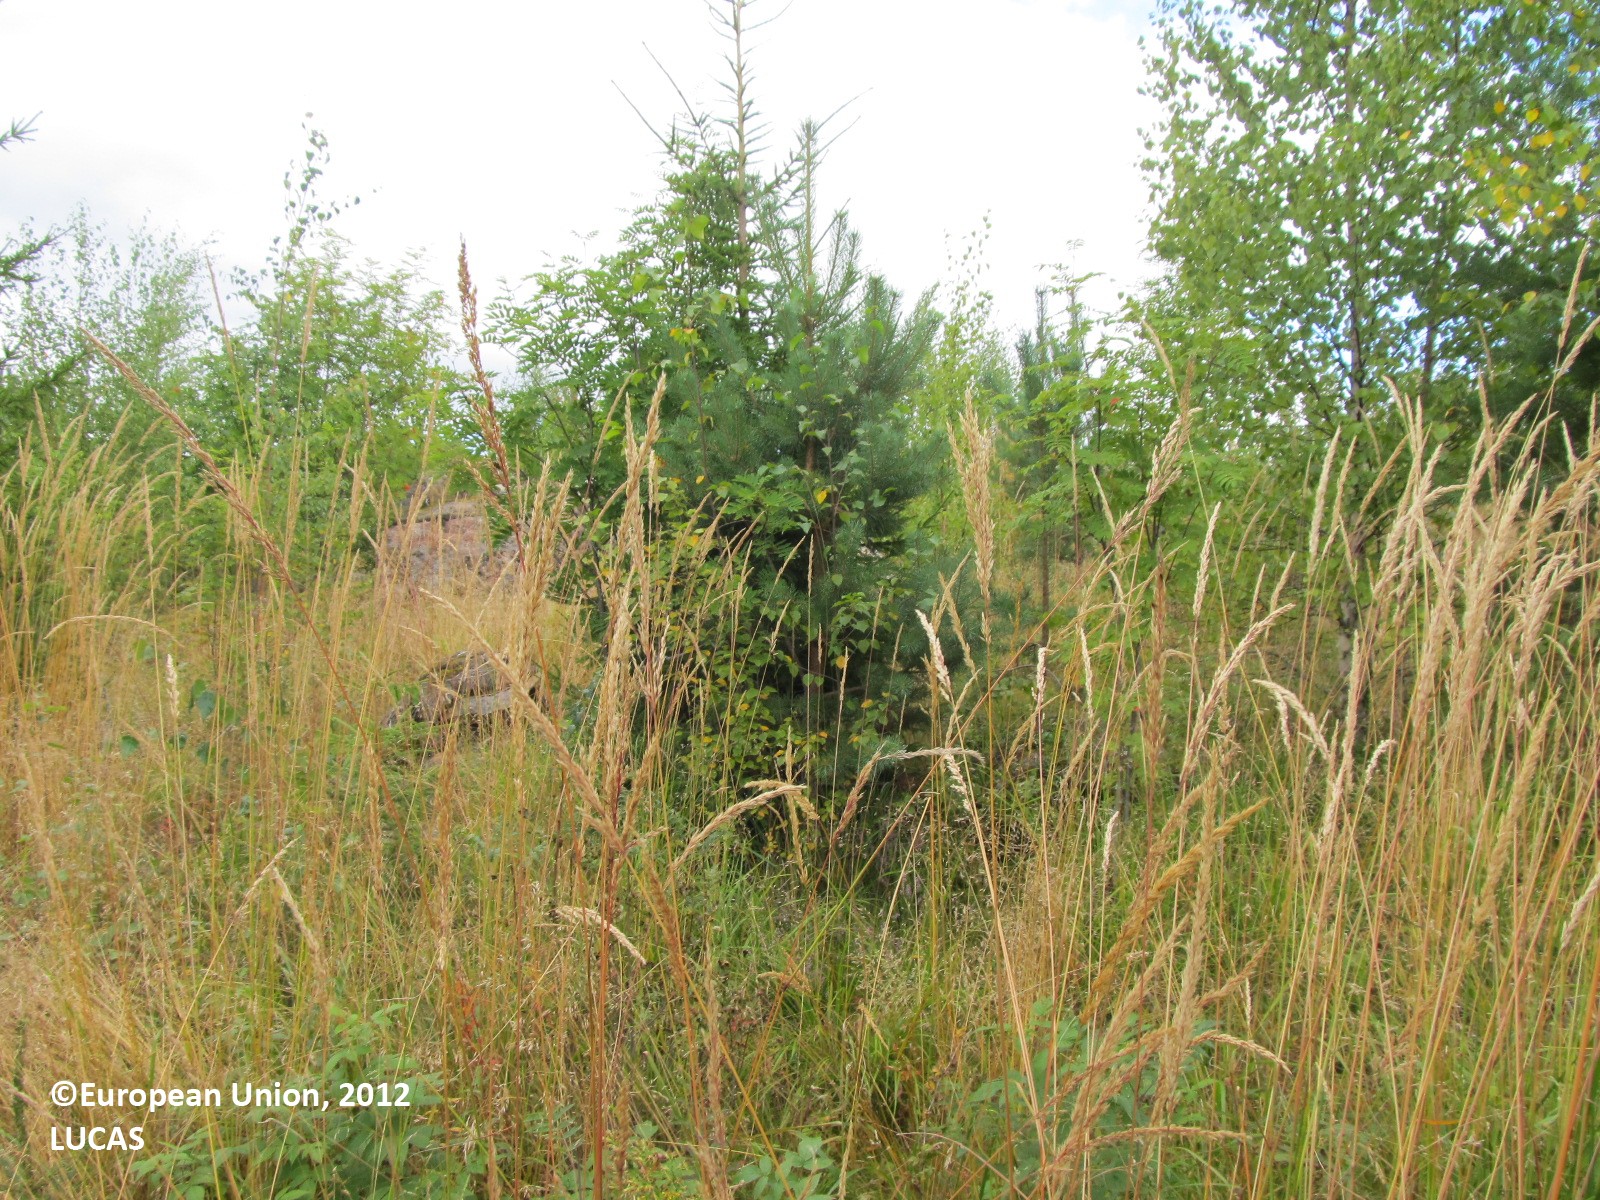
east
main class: Woodland
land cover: Spruce dominated mixed woodland
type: boreal forest
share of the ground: 25 - 50 %
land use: Forestry
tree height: < 5 m
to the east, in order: Spruce dominated mixed woodland; Tracks; Spruce dominated mixed woodland
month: August
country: FI
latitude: 61.7100
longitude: 27.7553
